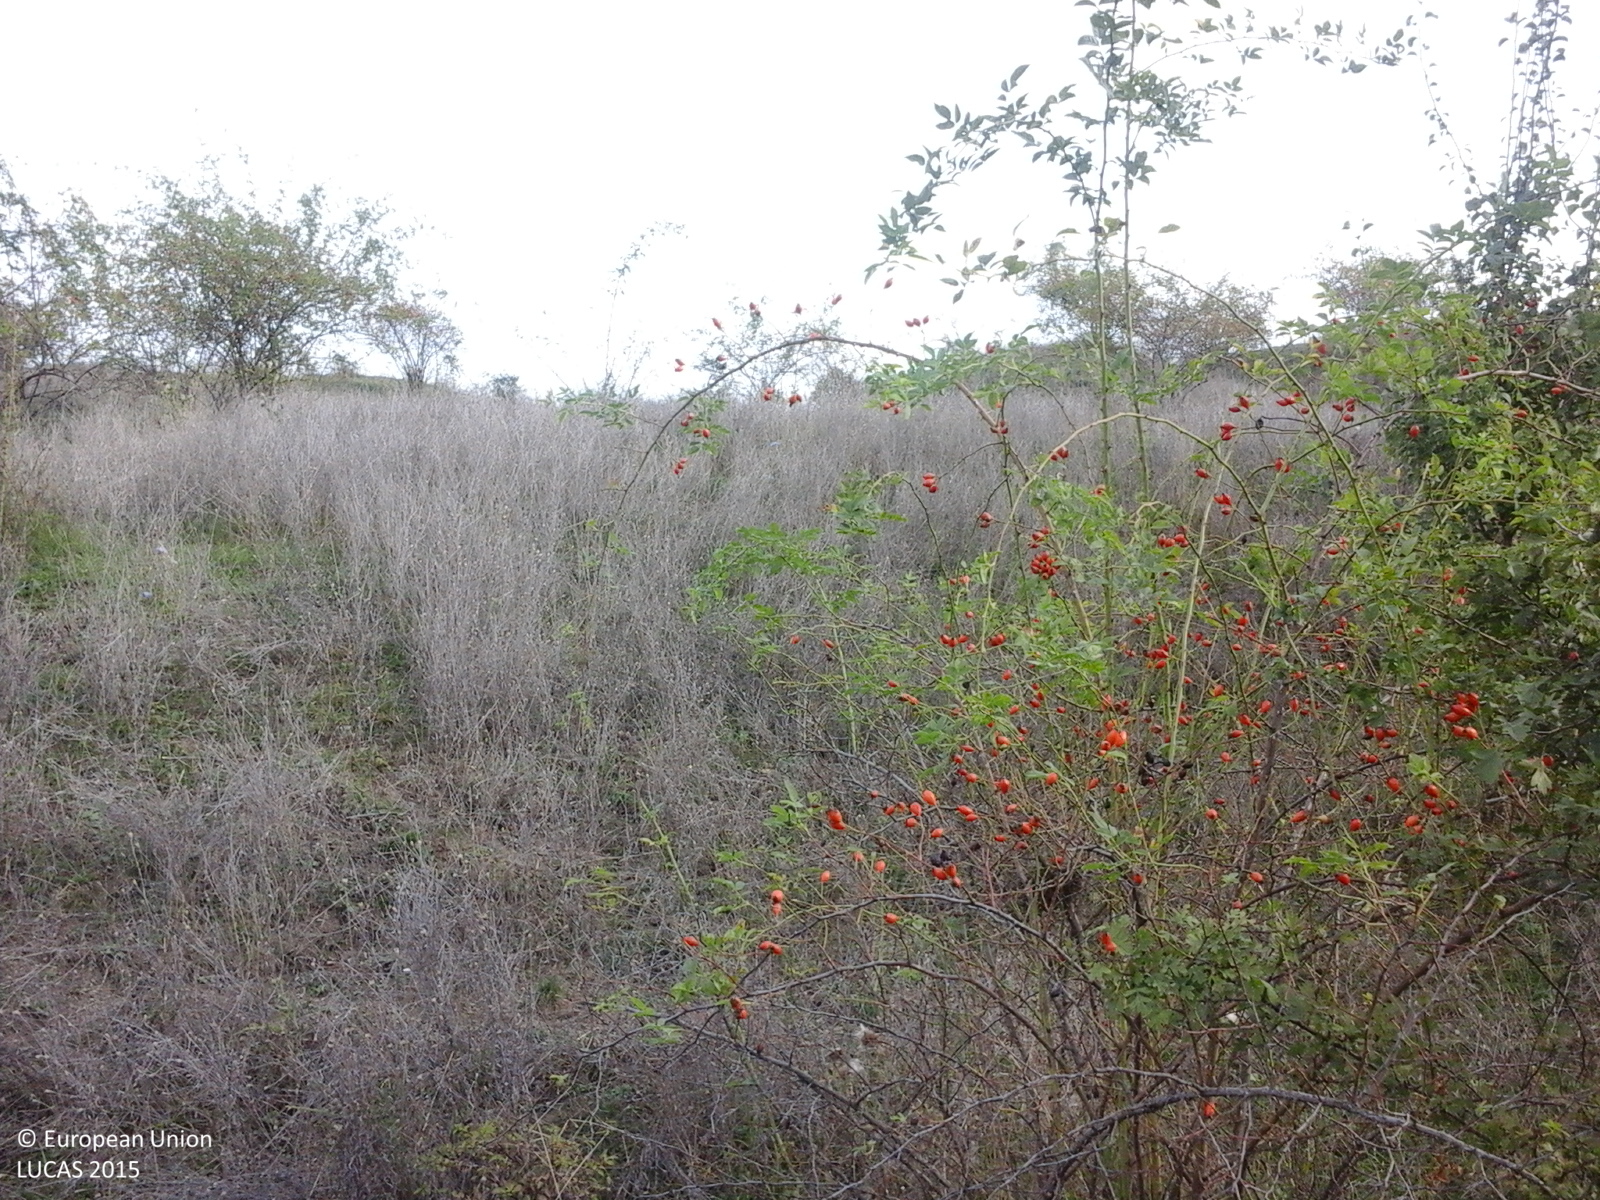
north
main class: Grassland
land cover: Grassland with sparse tree/shrub cover
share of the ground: > 75 %
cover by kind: herbaceous plants 90 %, broadleaved forest trees 5 %, shrubs 5 %
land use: Agriculture (excluding fallow land and kitchen gardens)
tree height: < 5 m
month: September
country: RO
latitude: 47.1774
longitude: 23.4371
